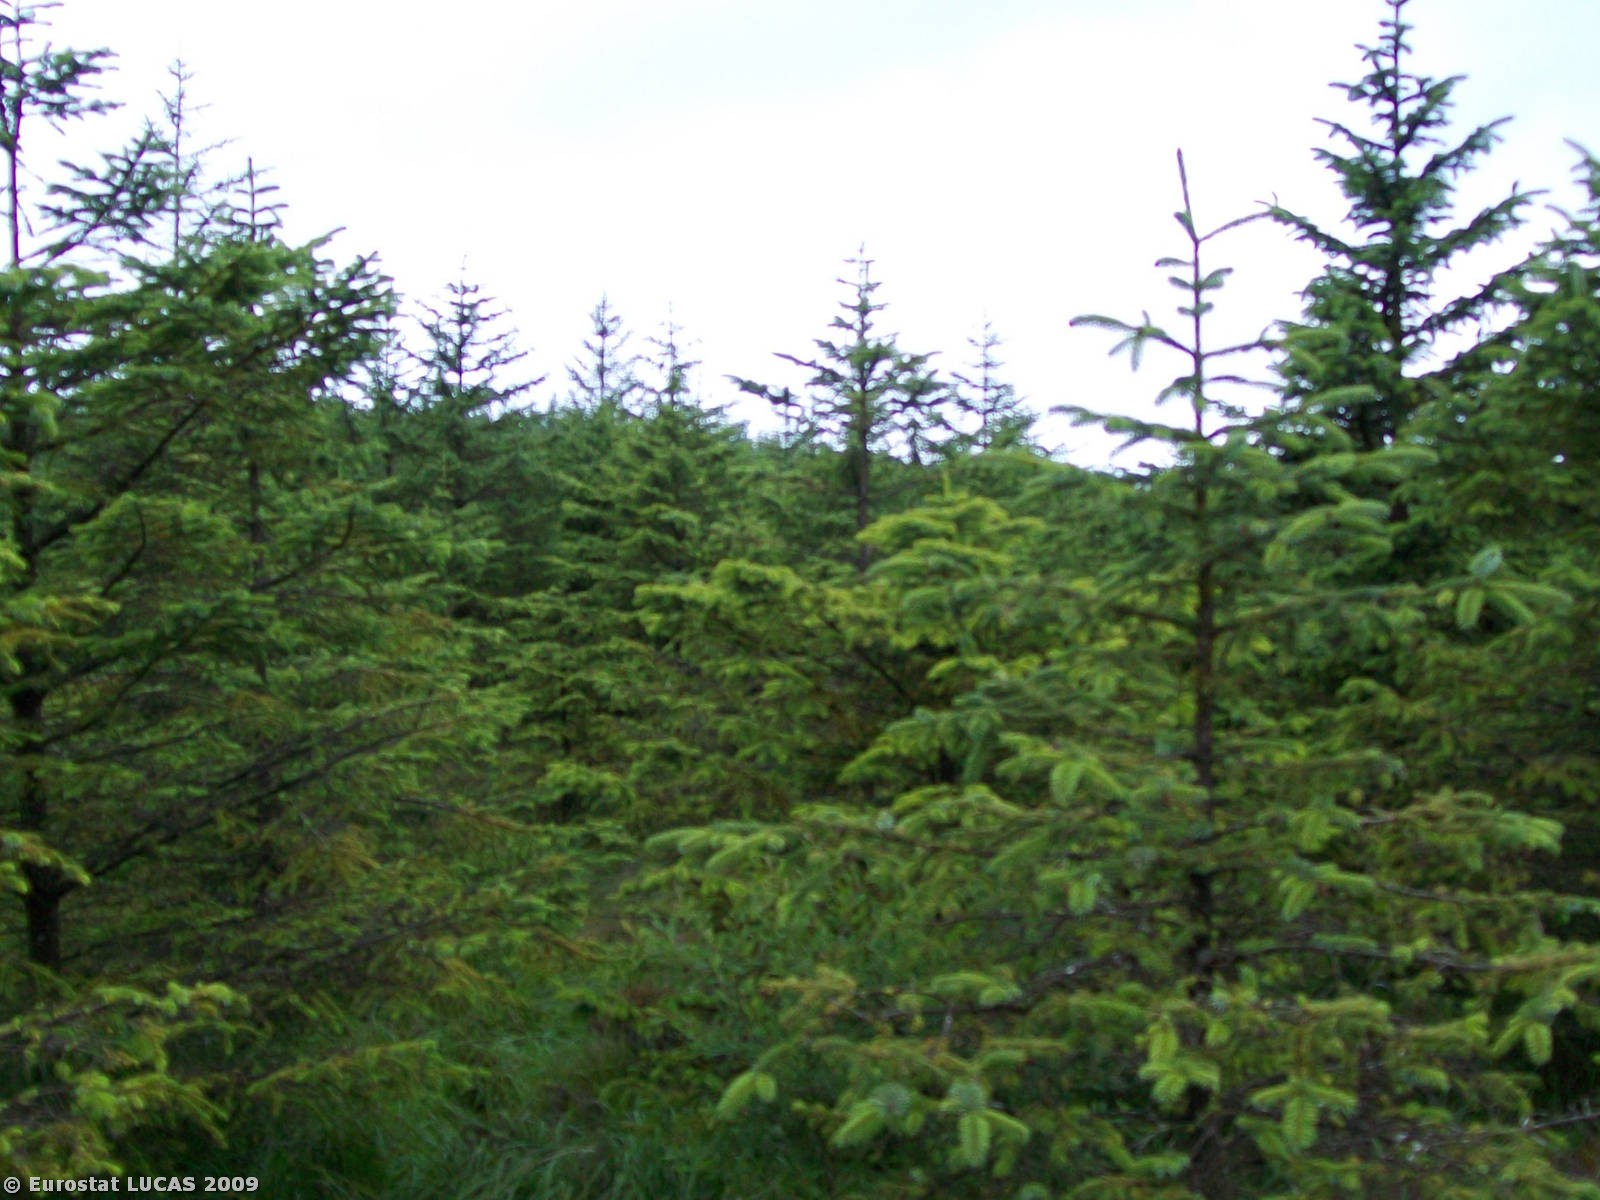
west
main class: Woodland
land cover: Coniferous woodland
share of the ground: > 75 %
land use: Forestry
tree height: < 5 m
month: August
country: IE
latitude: 53.3855
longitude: -9.3980
